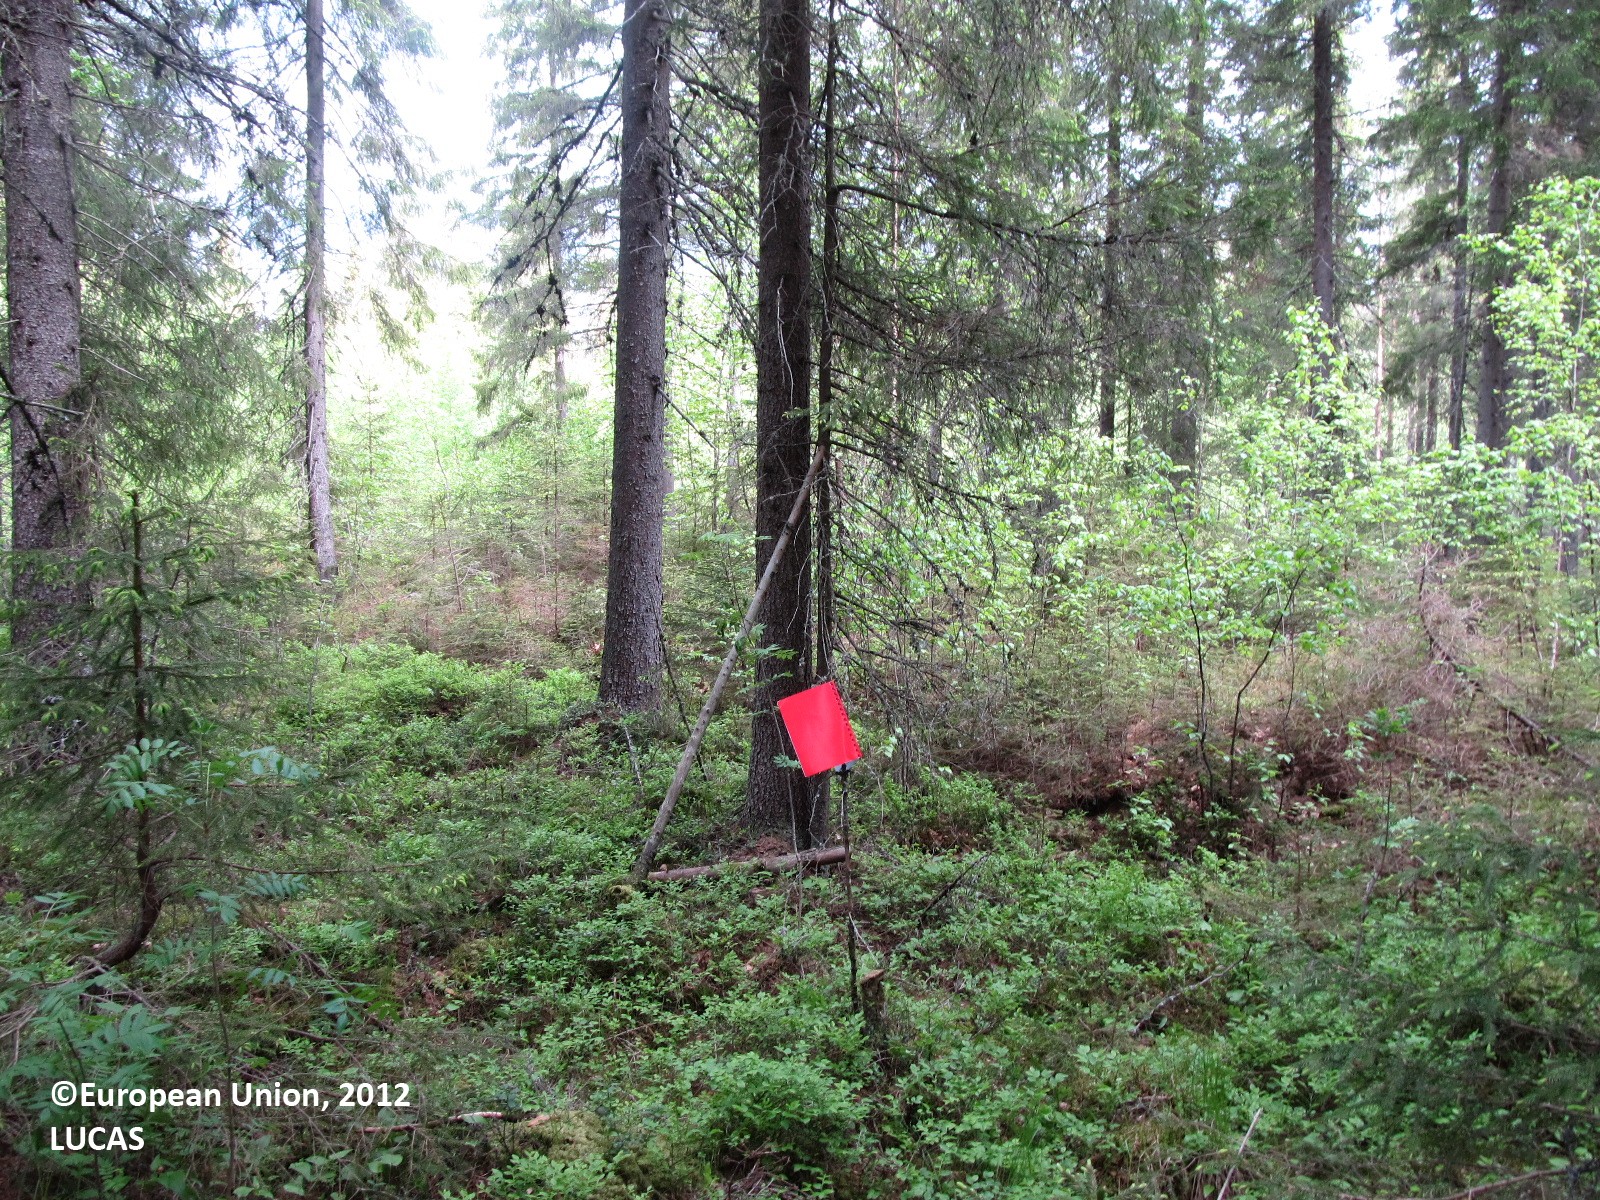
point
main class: Woodland
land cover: Spruce dominated coniferous woodland
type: boreal forest
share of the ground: 25 - 50 %
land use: Forestry
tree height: > 5 m
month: June
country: FI
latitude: 62.5361
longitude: 29.1763
